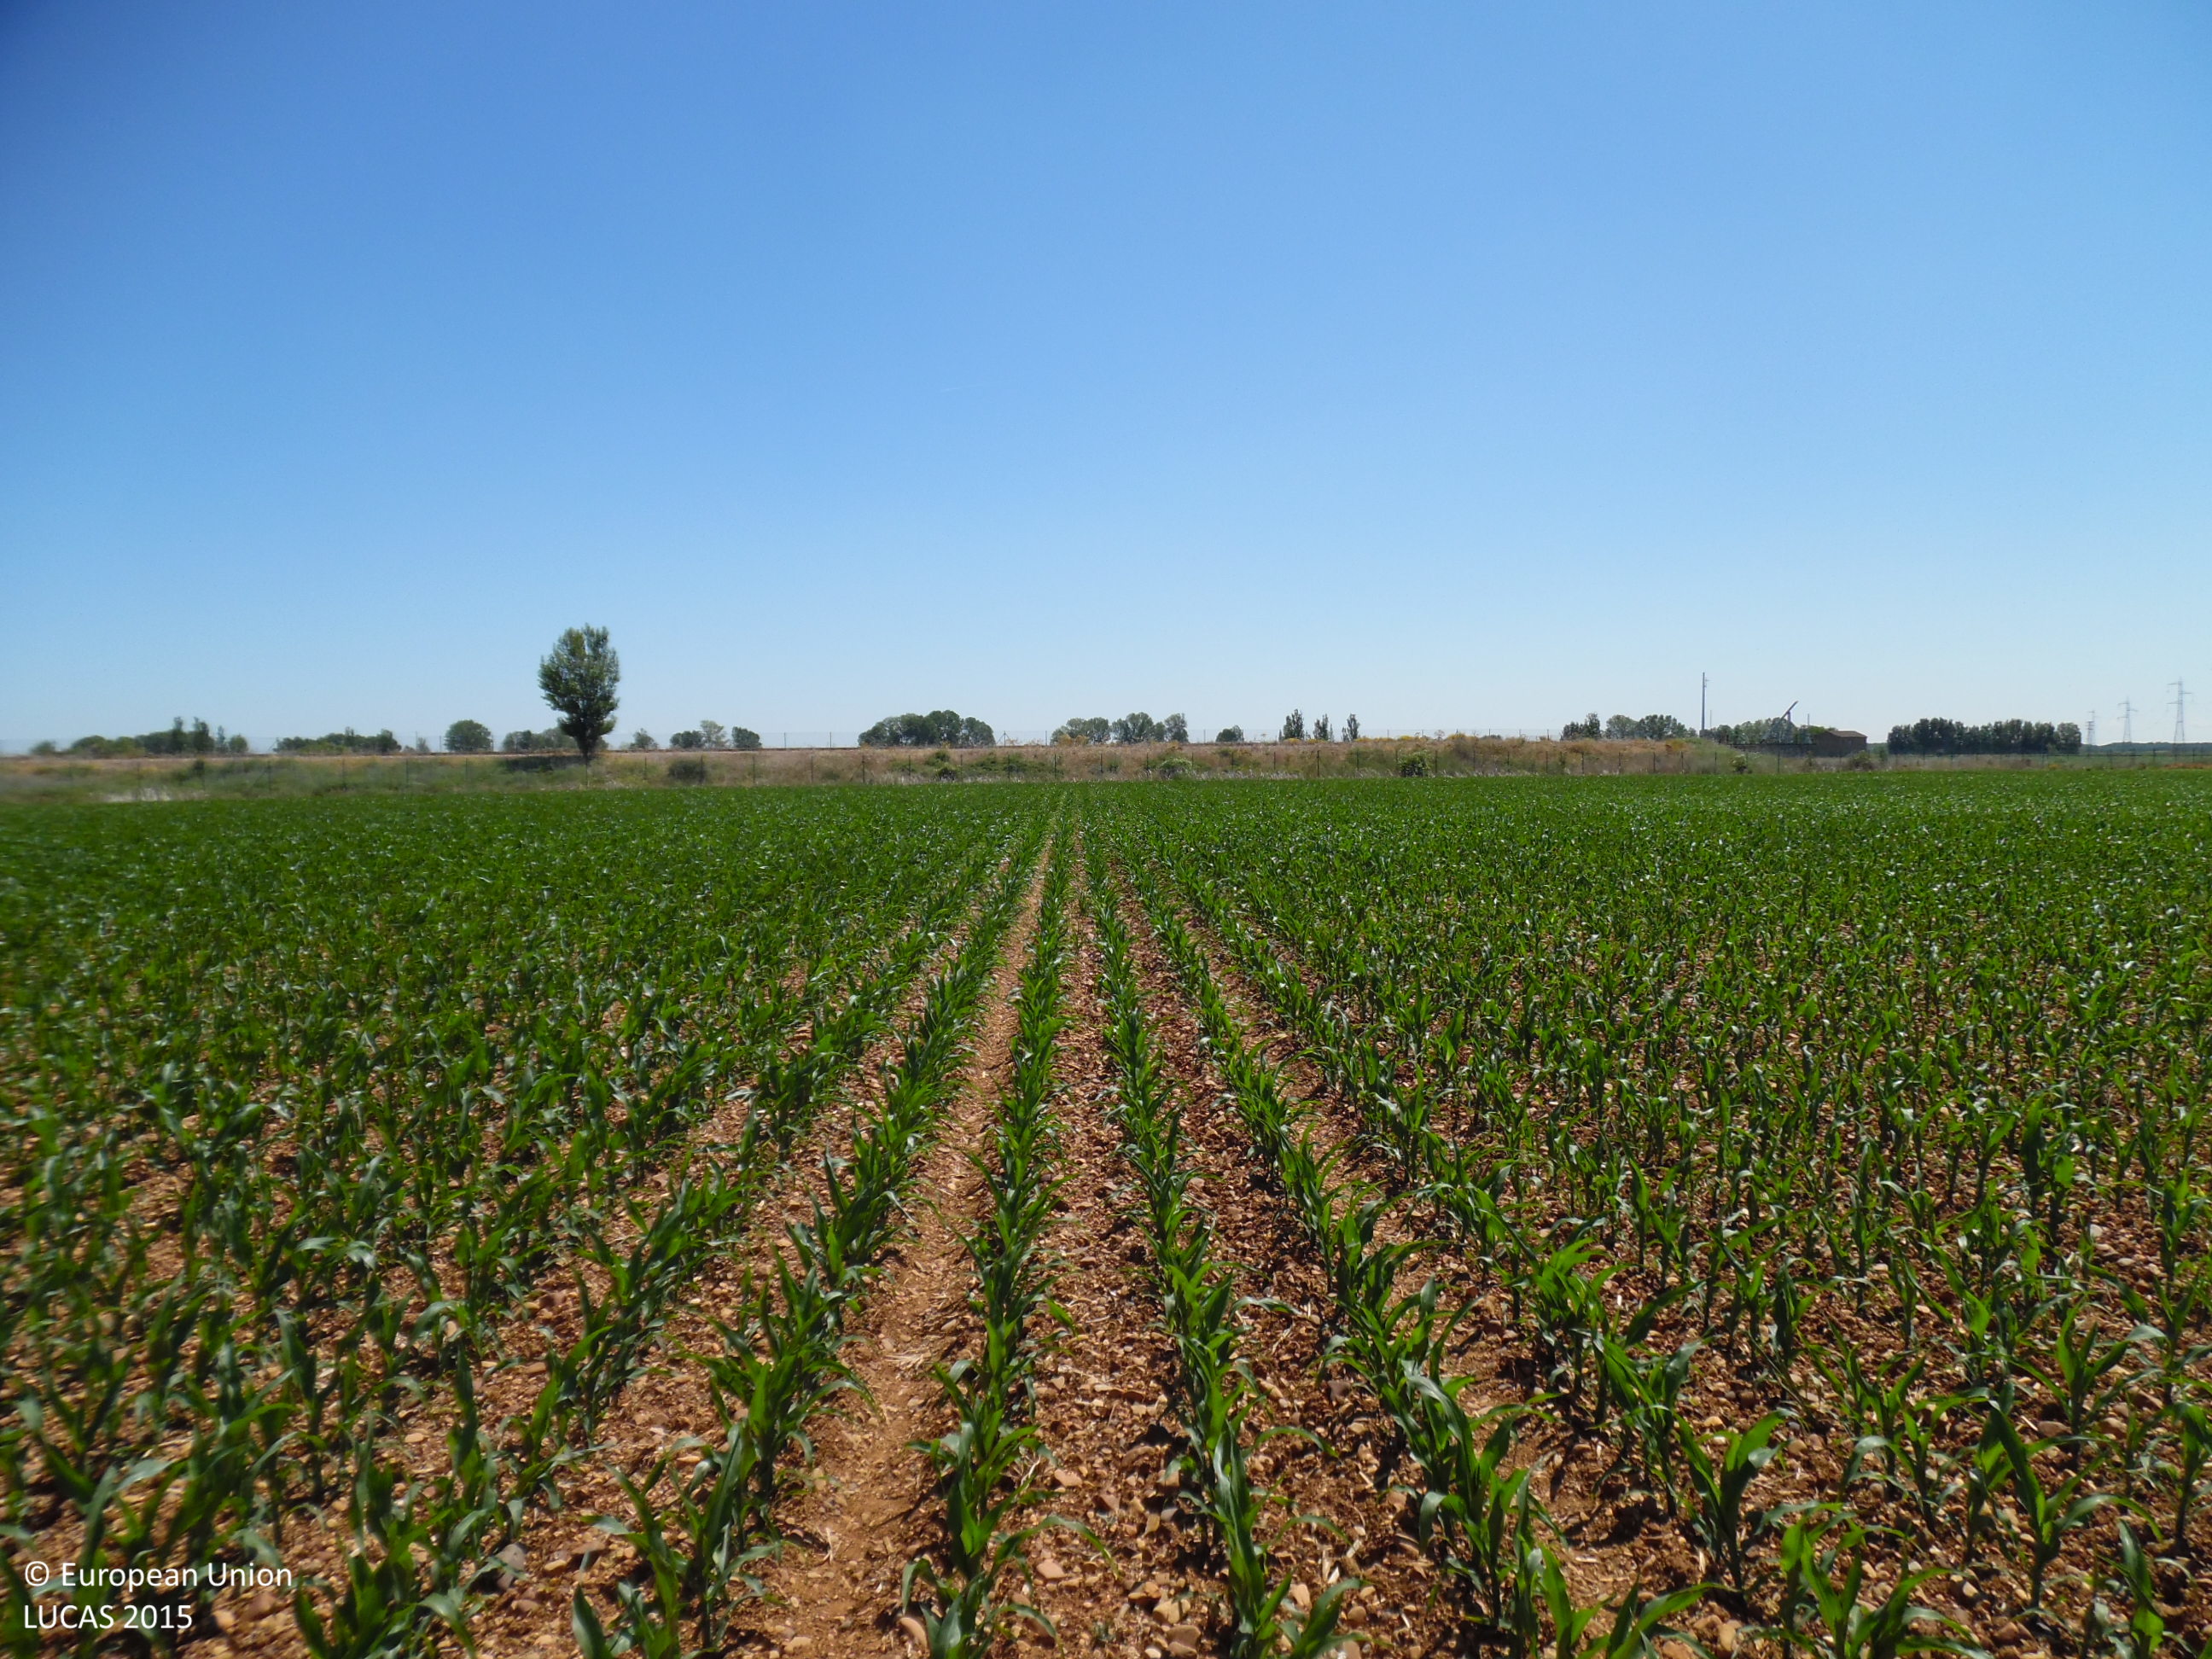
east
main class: Cropland
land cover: Maize
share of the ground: 25 - 50 %
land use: Agriculture (excluding fallow land and kitchen gardens)
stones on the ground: < 10 %
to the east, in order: Maize; Grass margins; Ditches and canals; Grass margins; Fences; Grassland with sparse tree/shrub cover; Tracks; Fences; Inland fresh water bodies
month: June
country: ES
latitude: 42.3223
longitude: -5.6886
